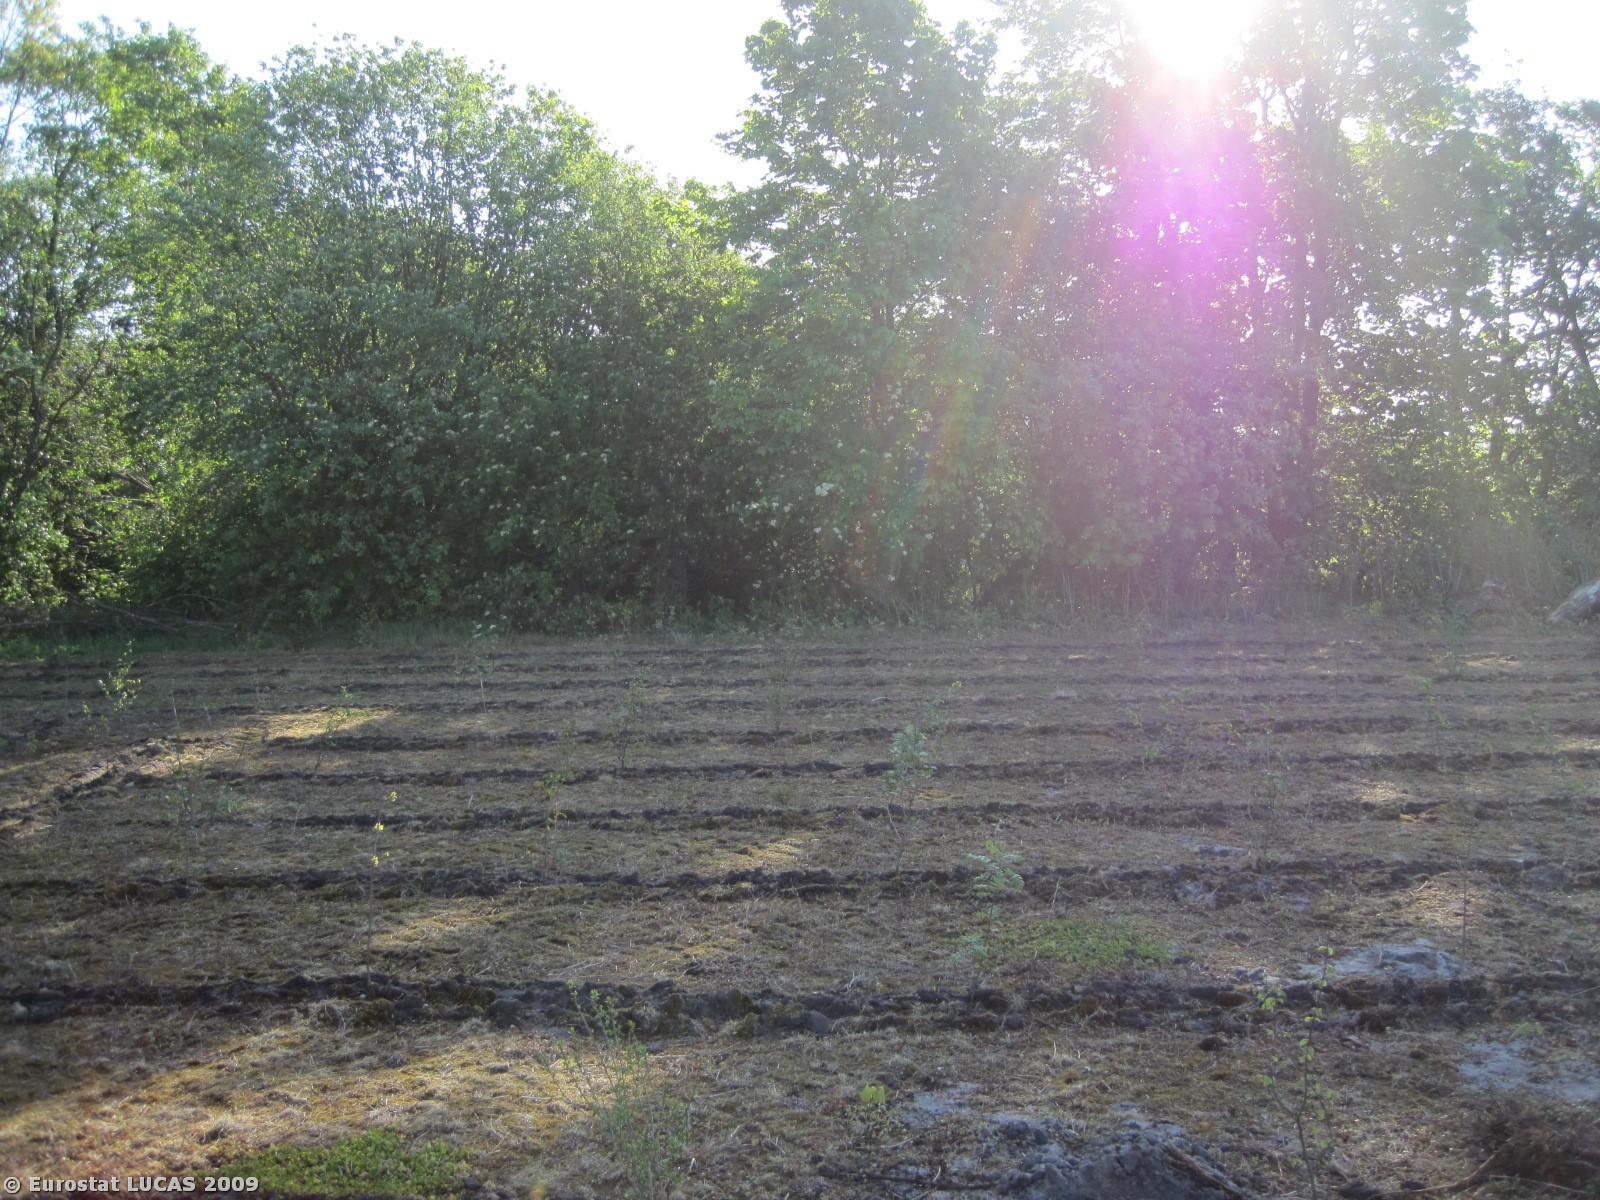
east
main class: Woodland
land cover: Broadleaved woodland
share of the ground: < 10 %
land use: Agriculture (excluding fallow land and kitchen gardens)
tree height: < 5 m
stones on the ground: < 10 %
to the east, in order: Broadleaved woodland; Grassland without tree/shrub cover; Broadleaved woodland; Grassland without tree/shrub cover; Barley; Broadleaved woodland; Barley
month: May
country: DK
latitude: 56.4012
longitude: 9.2394
